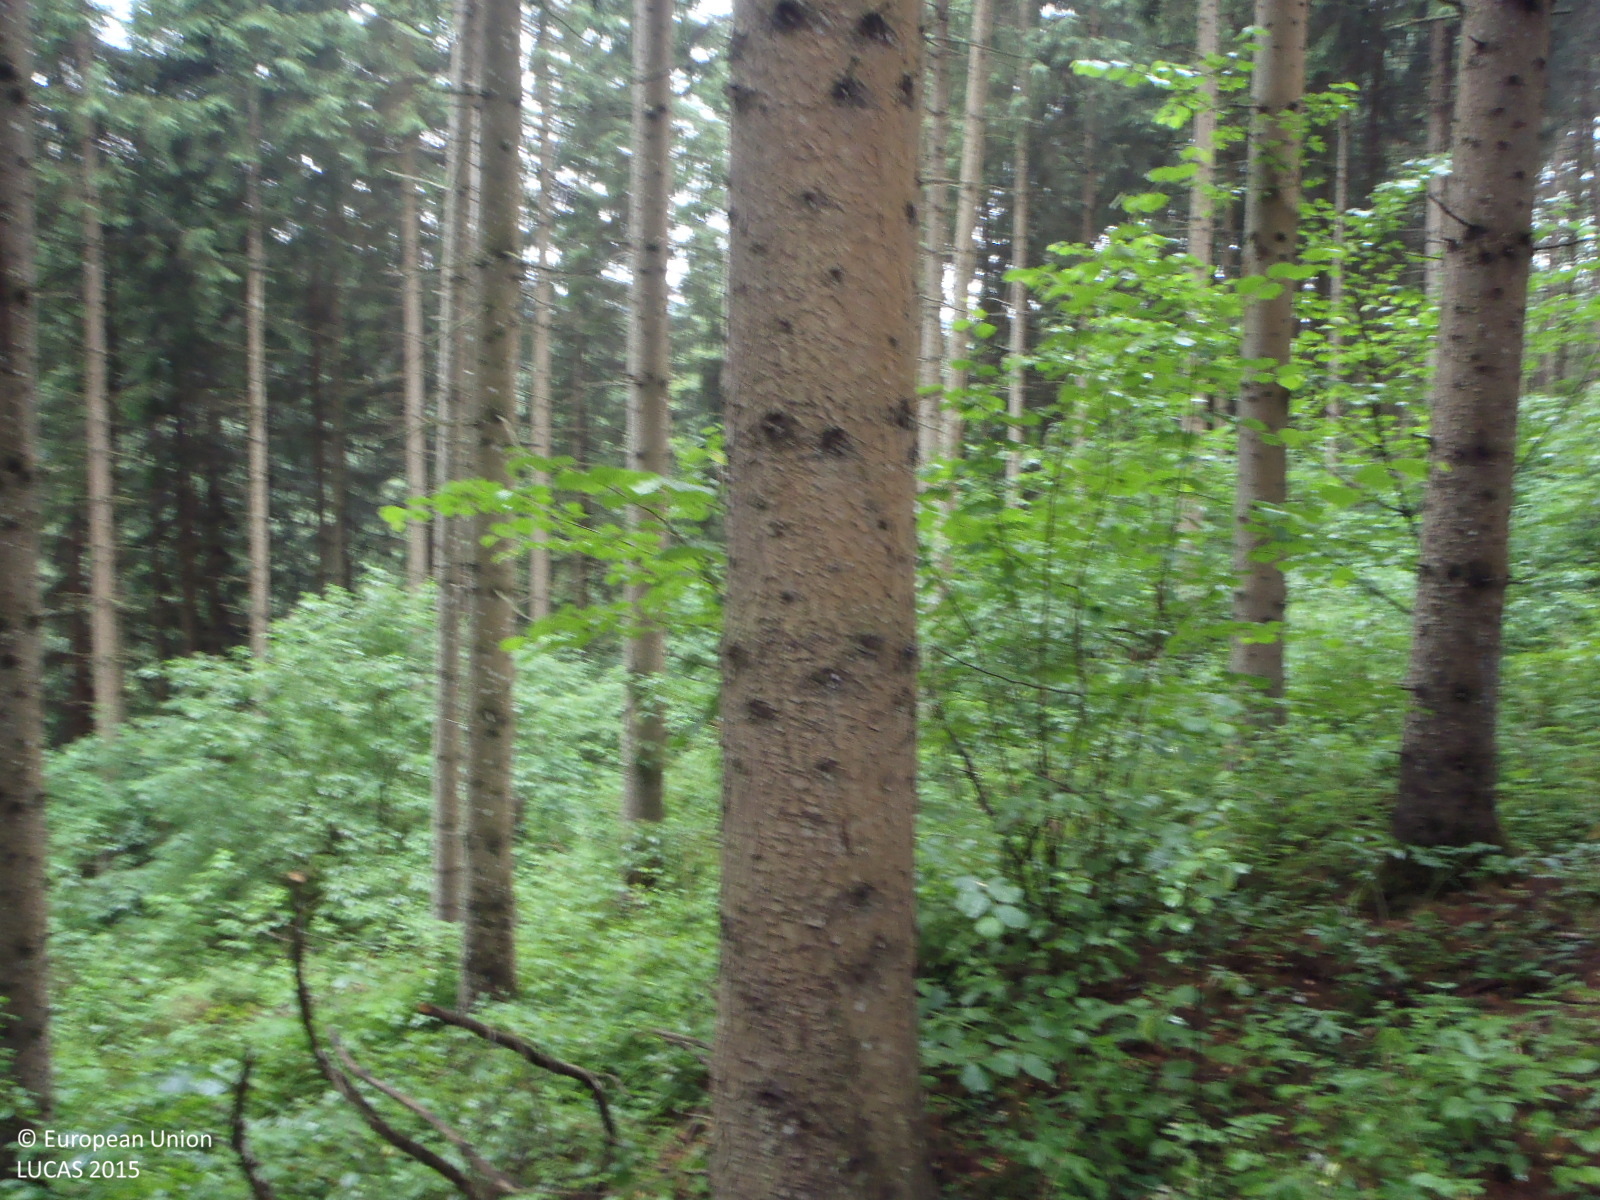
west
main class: Woodland
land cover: Spruce dominated coniferous woodland
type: alpine coniferous forest
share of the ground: > 75 %
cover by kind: coniferous forest trees 80 %, broadleaved forest trees 20 %
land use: Forestry
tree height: > 5 m
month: July
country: AT
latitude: 47.4277
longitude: 12.1858
